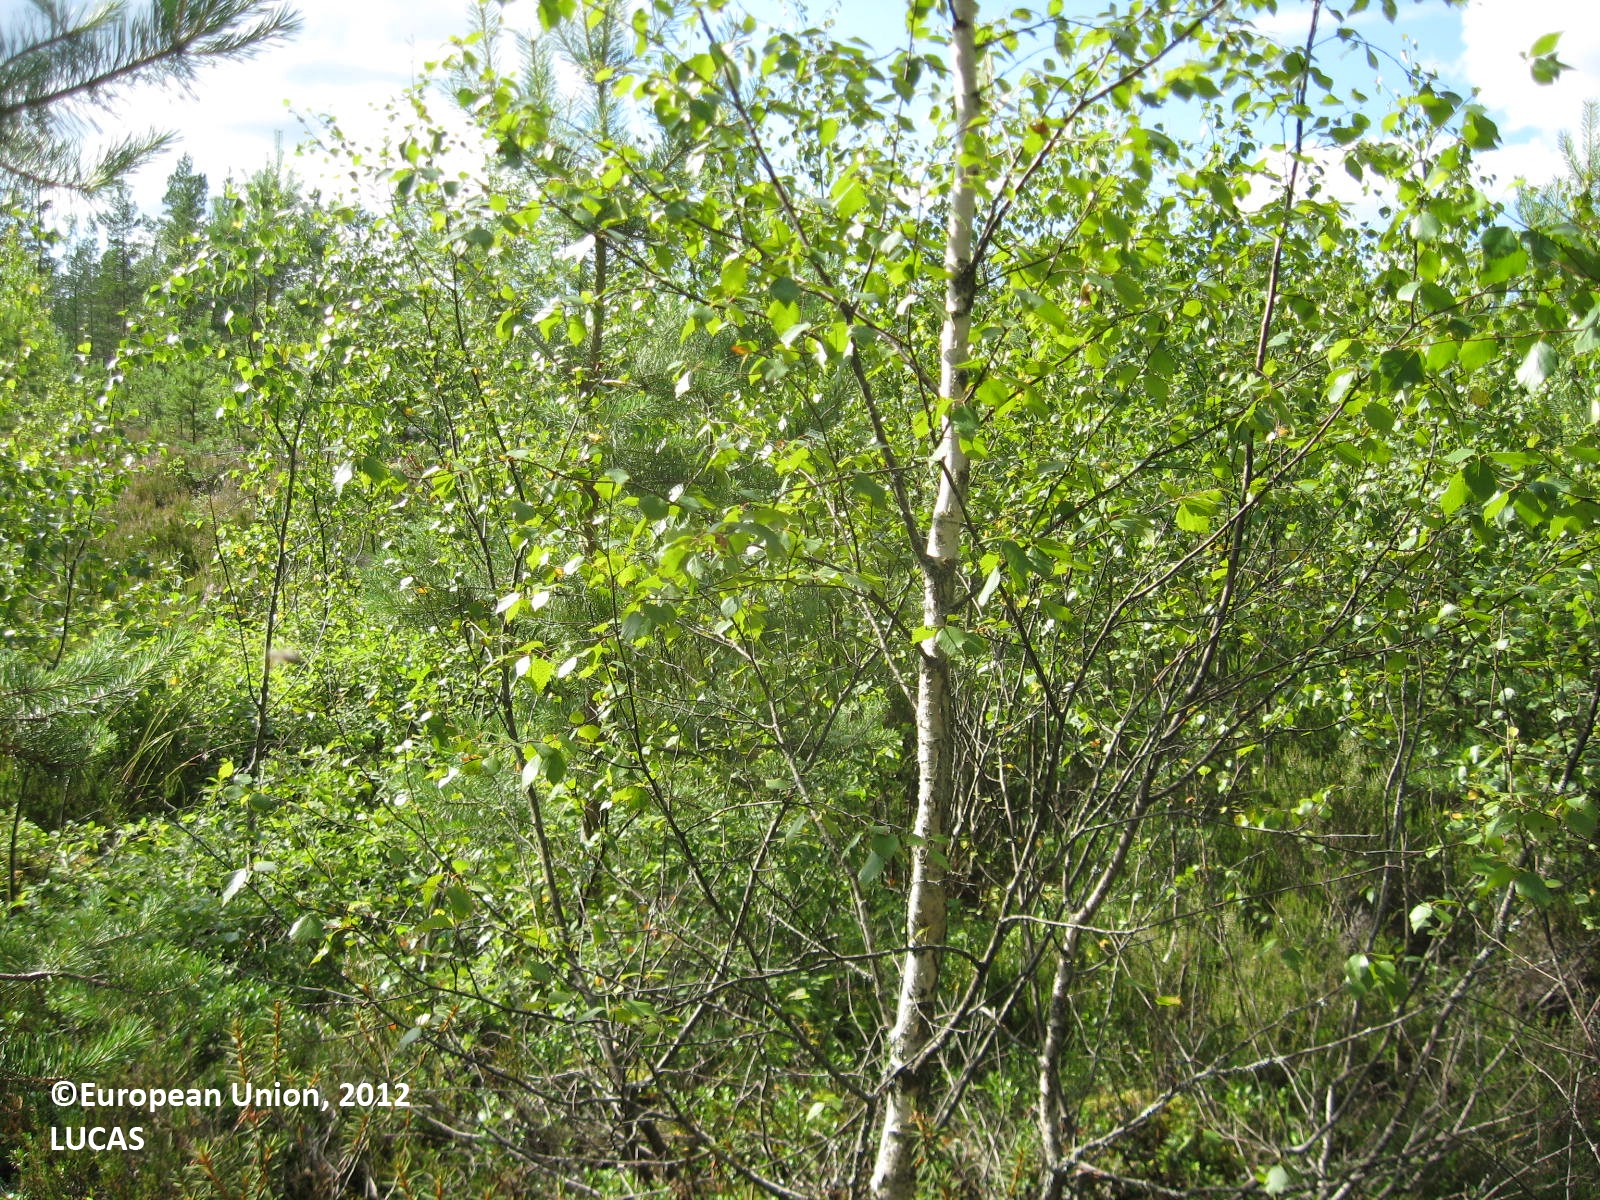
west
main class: Woodland
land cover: Pine dominated mixed woodland
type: boreal forest
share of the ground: > 75 %
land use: Forestry
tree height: > 5 m
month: July
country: FI
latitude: 62.0243
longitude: 22.6158
